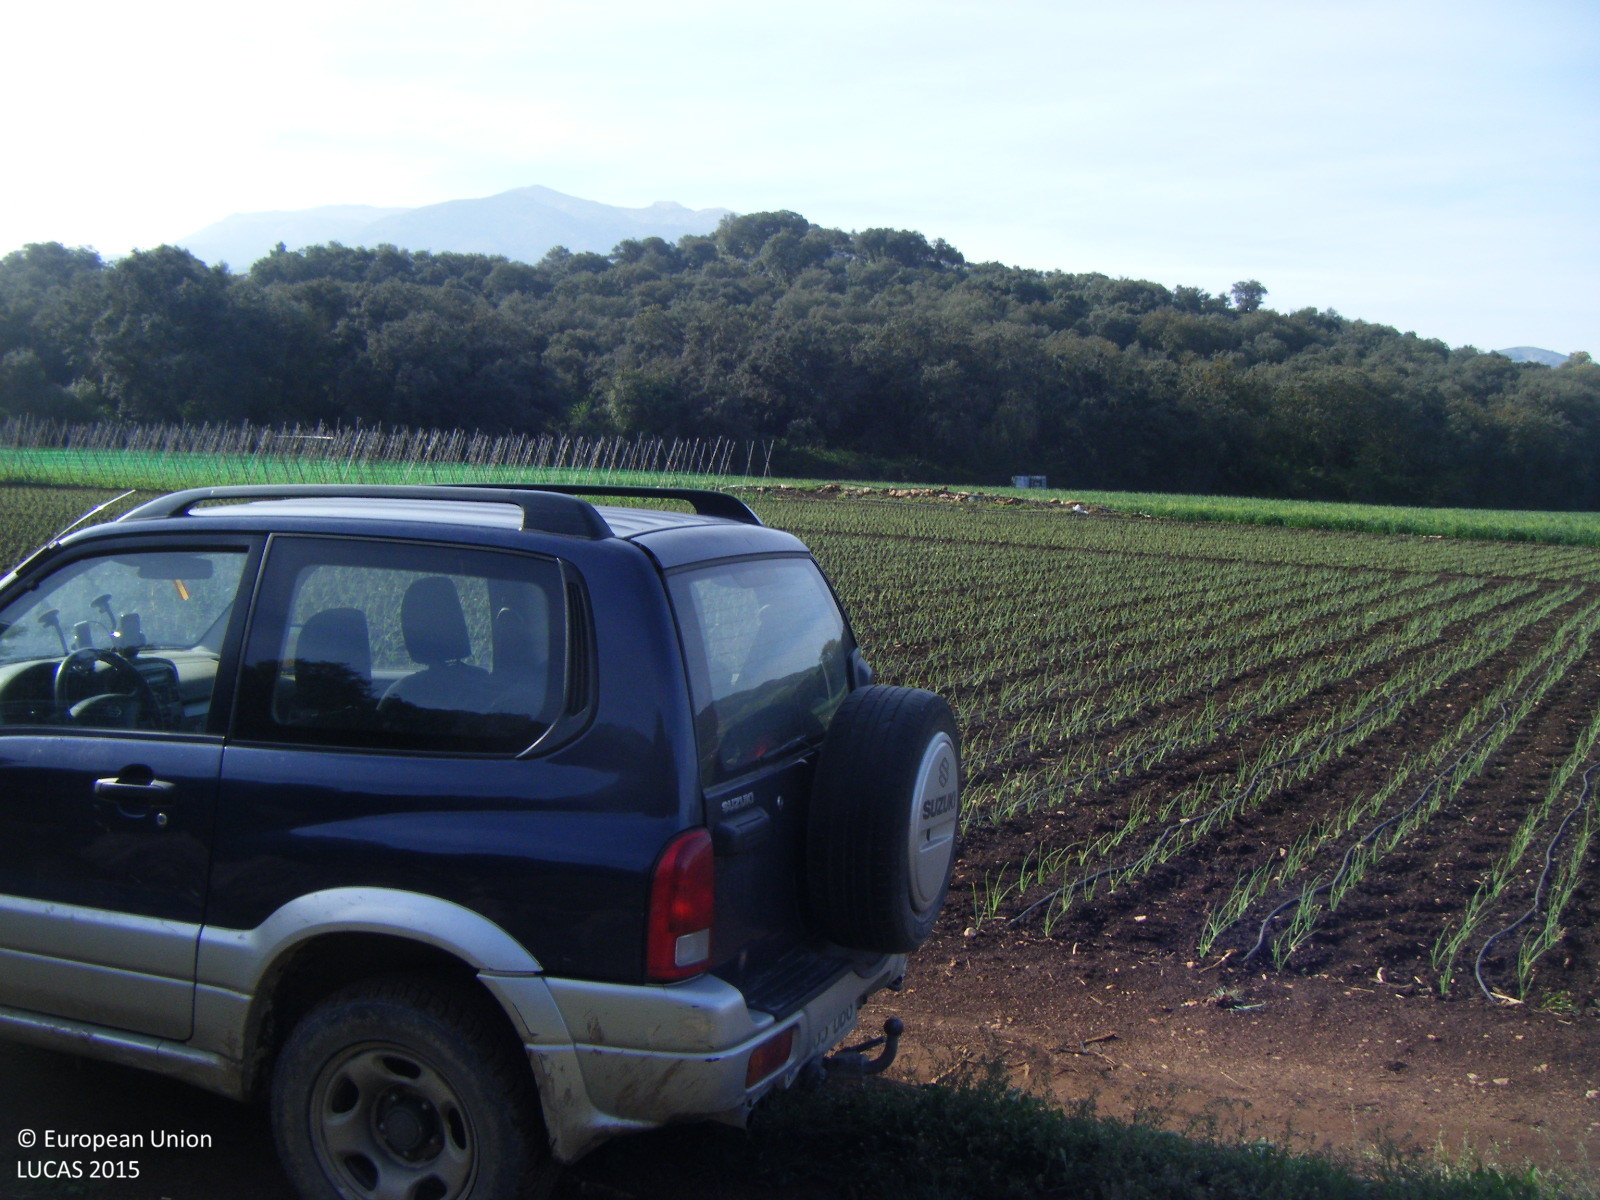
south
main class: Woodland
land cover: Broadleaved woodland
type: broadleaved evergreen forest
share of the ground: 10 - 25 %
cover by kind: herbaceous plants 50 %, broadleaved forest trees 25 %, shrubs 25 %
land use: Forestry
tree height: > 5 m
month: April
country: ES
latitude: 36.9689
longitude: -4.0873
